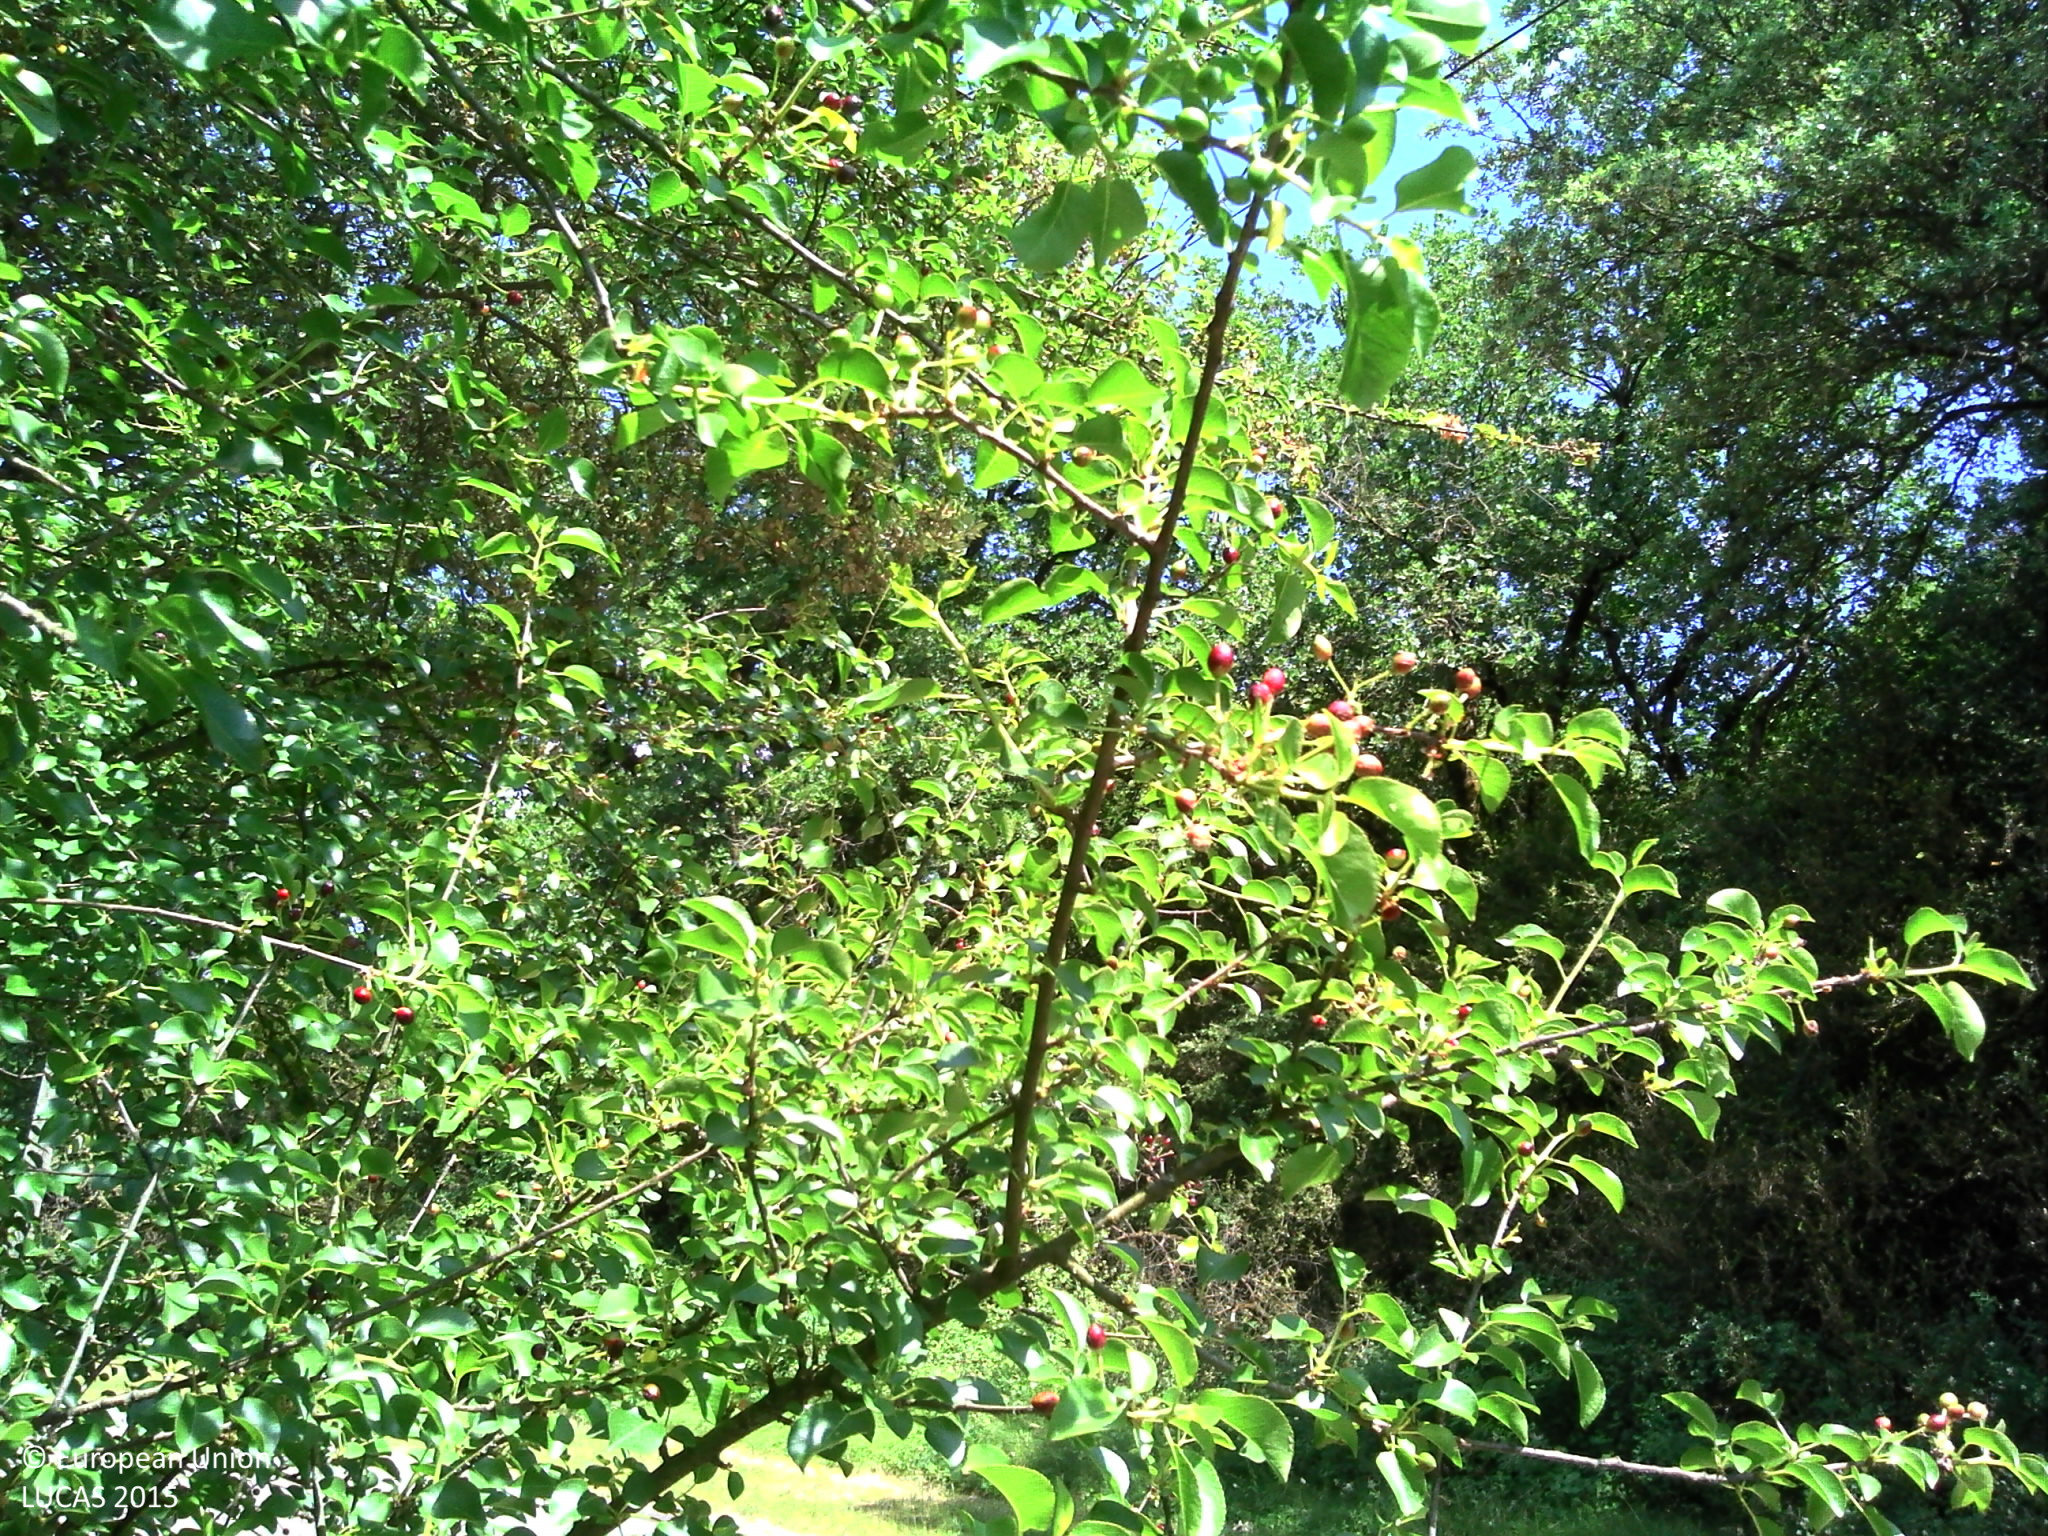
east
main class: Woodland
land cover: Broadleaved woodland
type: thermophilous deciduous forest
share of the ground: > 75 %
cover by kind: broadleaved forest trees 95 %, herbaceous plants 5 %
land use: Semi-natural and natural areas not in use
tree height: > 5 m
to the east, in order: Broadleaved woodland; Grass margins; Paved roads, cycling and walking lanes; Grass margins; Electric lines; Broadleaved woodland; Grassland without tree/shrub cover; Artificial constructions in urban areas; Other fruit trees and berries
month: May
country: FR
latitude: 45.0029
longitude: 4.9183
